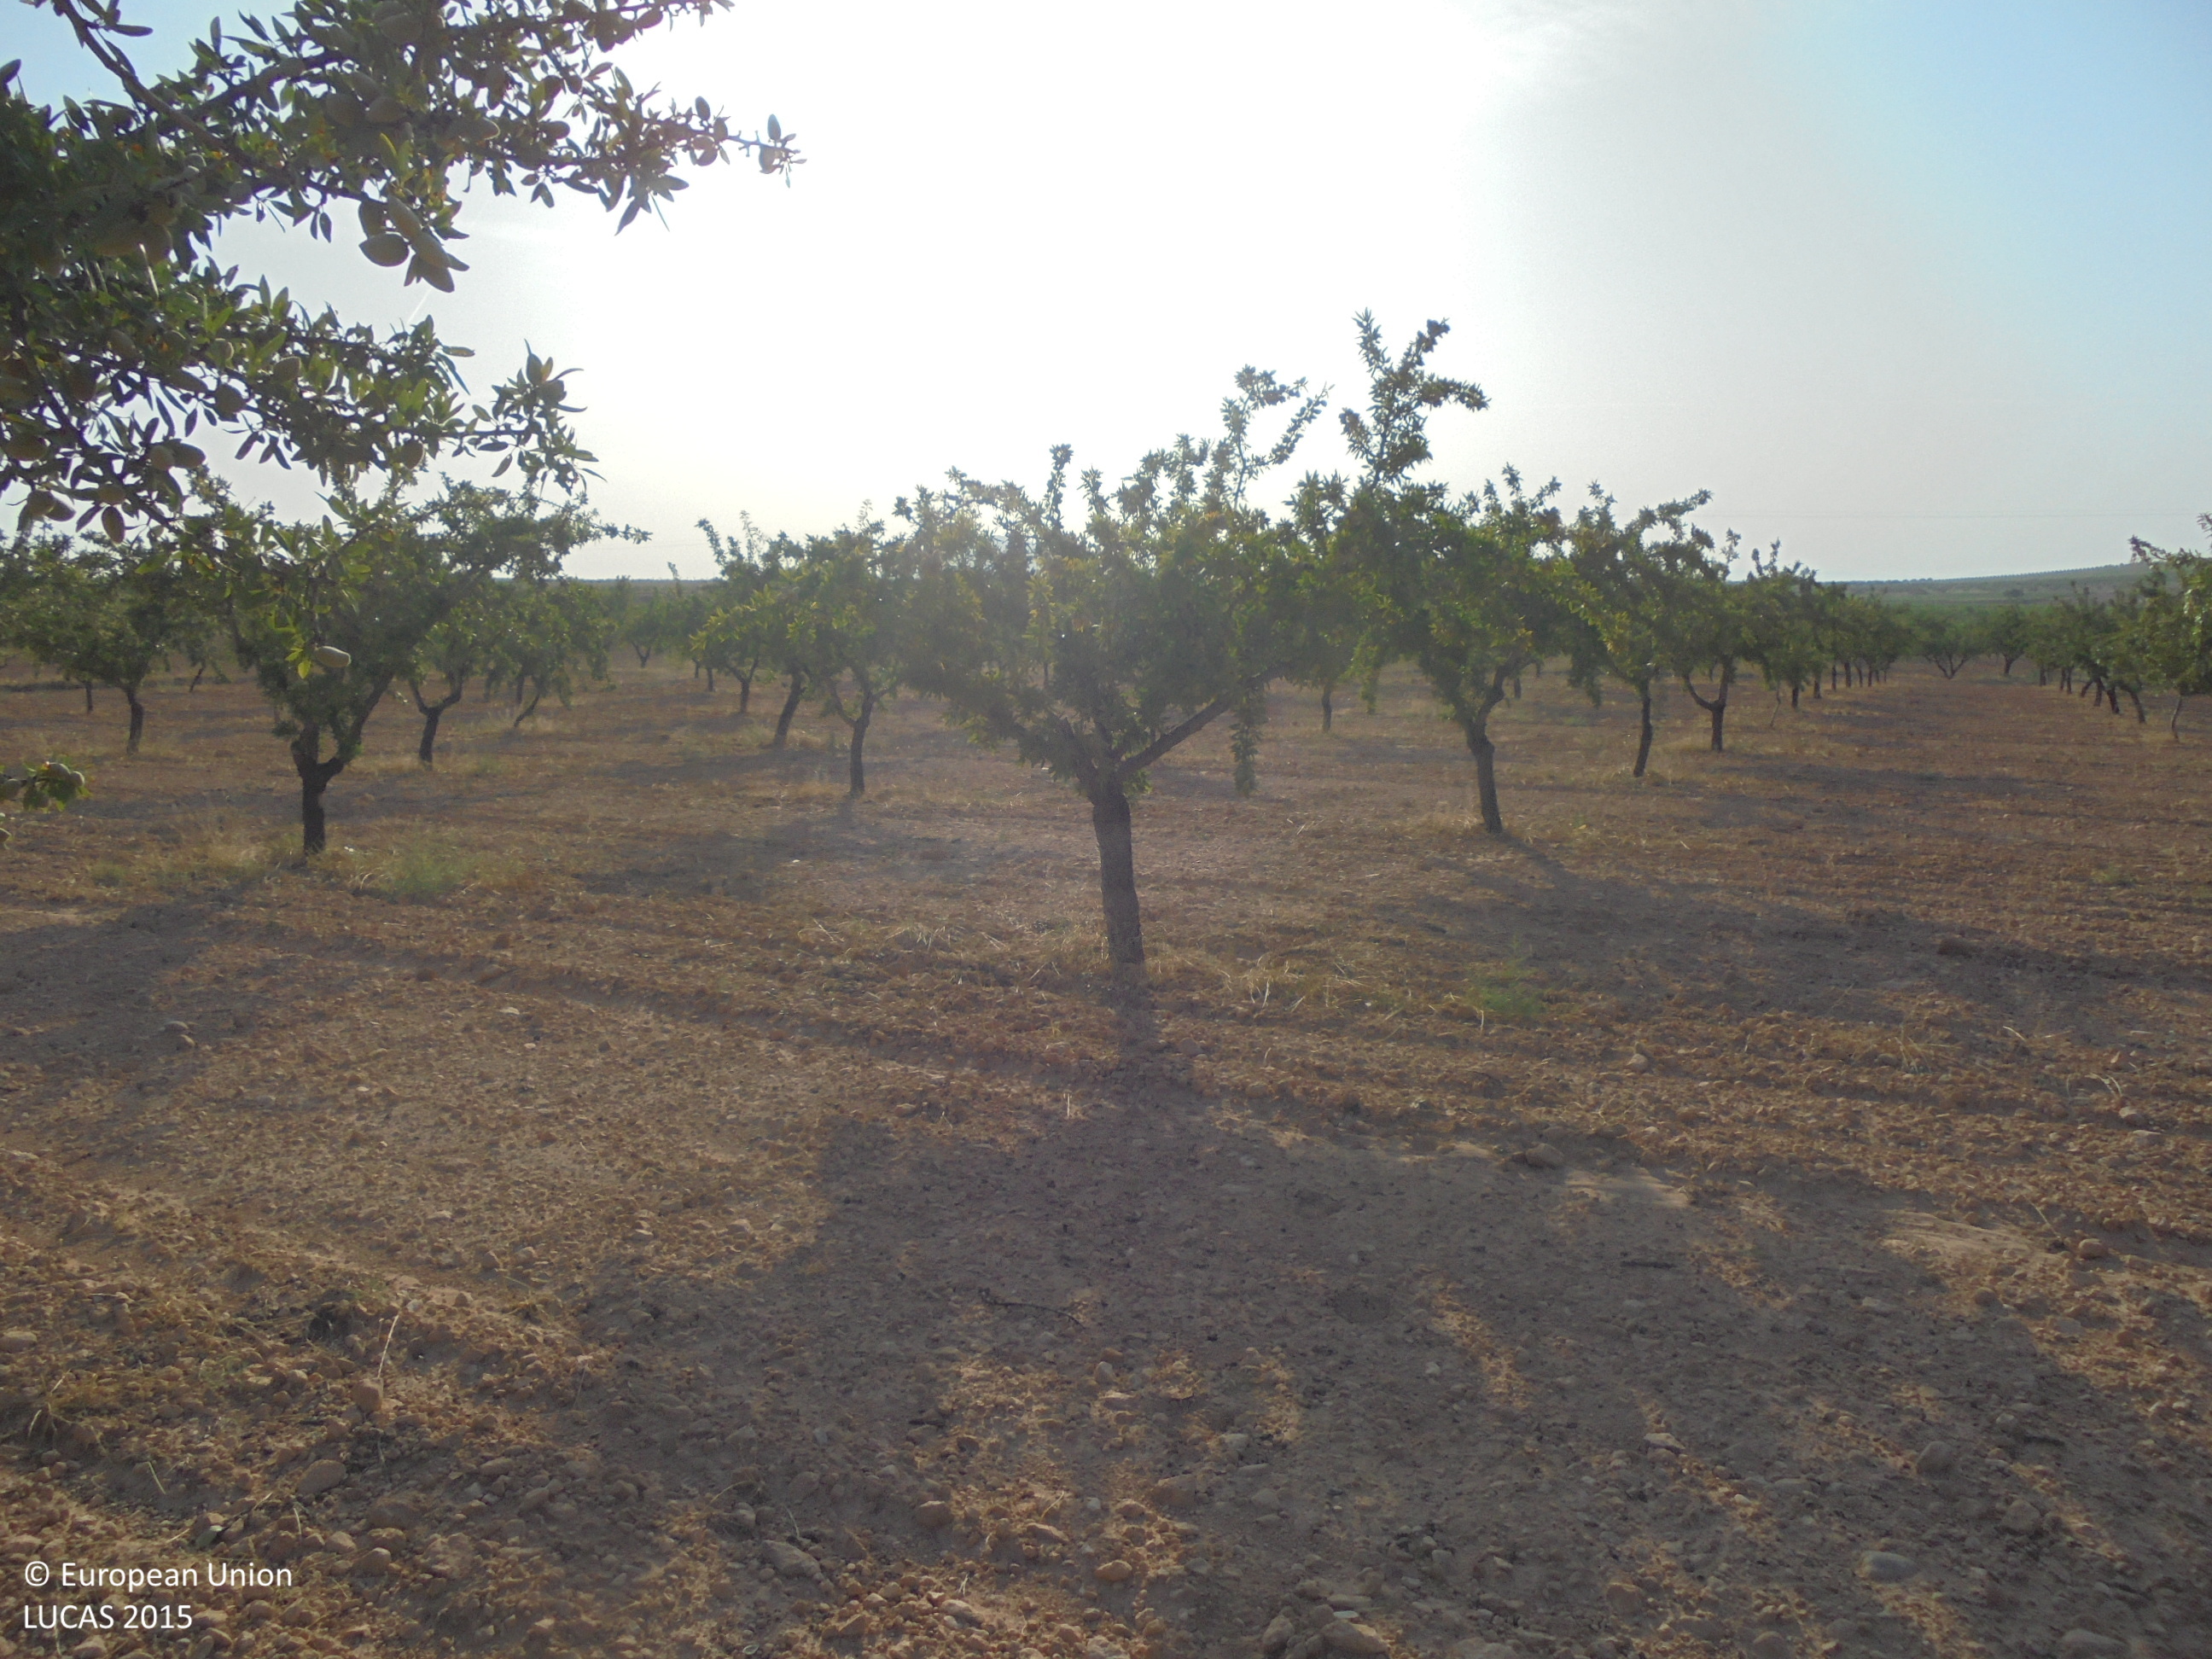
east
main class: Cropland
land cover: Nuts trees
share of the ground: 25 - 50 %
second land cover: Other bare soil
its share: > 75 %
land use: Agriculture (excluding fallow land and kitchen gardens)
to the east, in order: Nuts trees; Other bare soil; Grassland without tree/shrub cover; Dry stone walls; Nuts trees; Electric lines; Nuts trees; Grass margins; Vineyards; Single bushes/trees; Vineyards; Grass margins; Tracks; Grass margins; Vineyards; Shrubland without tree cover; Dry stone walls
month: July
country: ES
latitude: 38.6231
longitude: -1.6296
